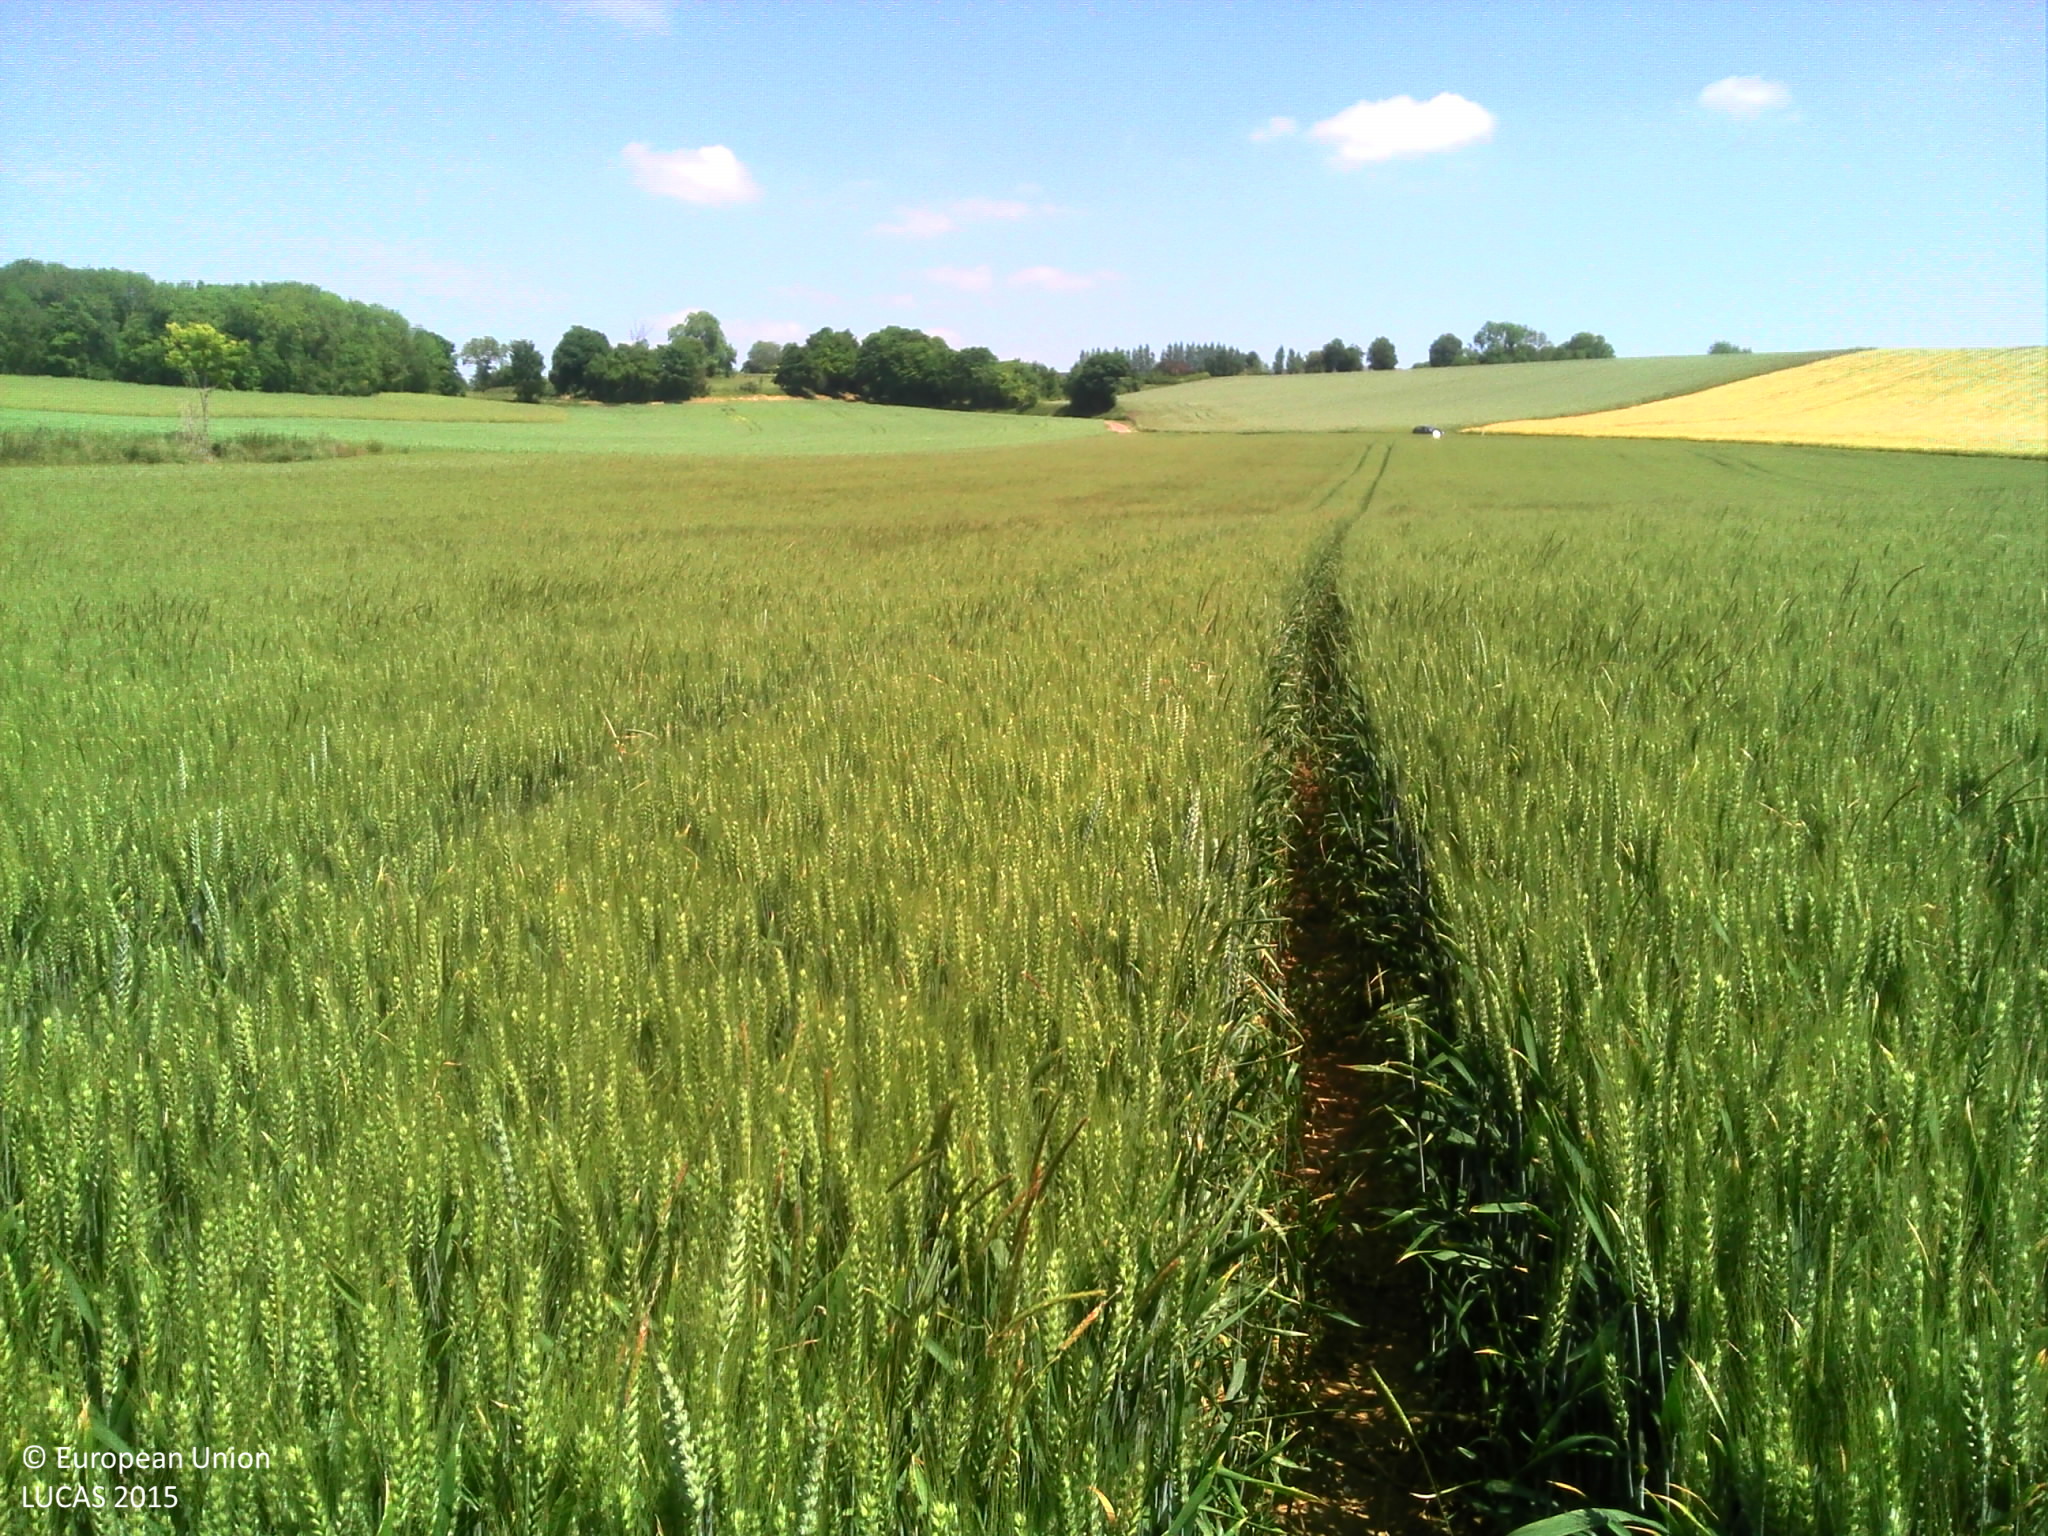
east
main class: Cropland
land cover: Common wheat
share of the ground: > 75 %
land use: Agriculture (excluding fallow land and kitchen gardens)
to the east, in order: Common wheat; Grass margins; Paved roads, cycling and walking lanes; Grass margins; Common wheat
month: June
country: FR
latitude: 49.7118
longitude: 2.3735
